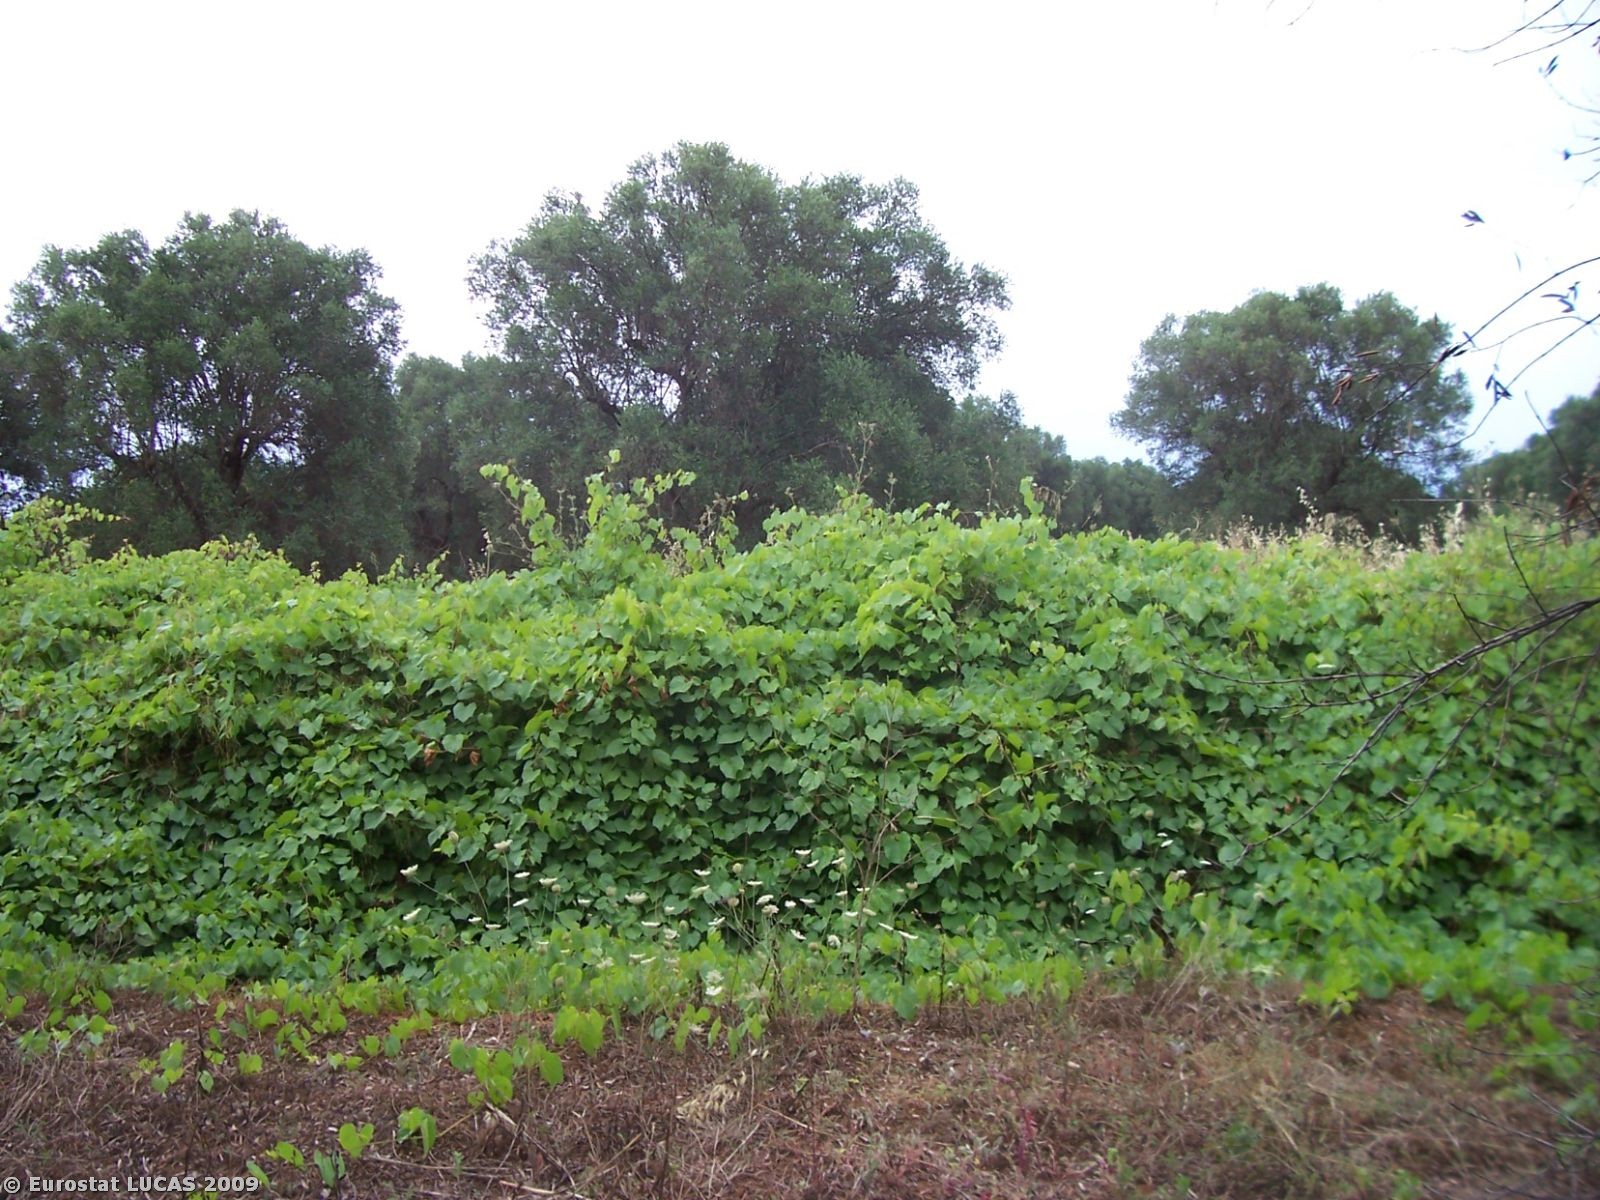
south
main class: Cropland
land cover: Olive groves
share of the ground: 25 - 50 %
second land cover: Spontaneously vegetated surfaces
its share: > 75 %
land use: Agriculture (excluding fallow land and kitchen gardens)
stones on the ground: < 10 %
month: June
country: IT
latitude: 40.3615
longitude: 17.4995
